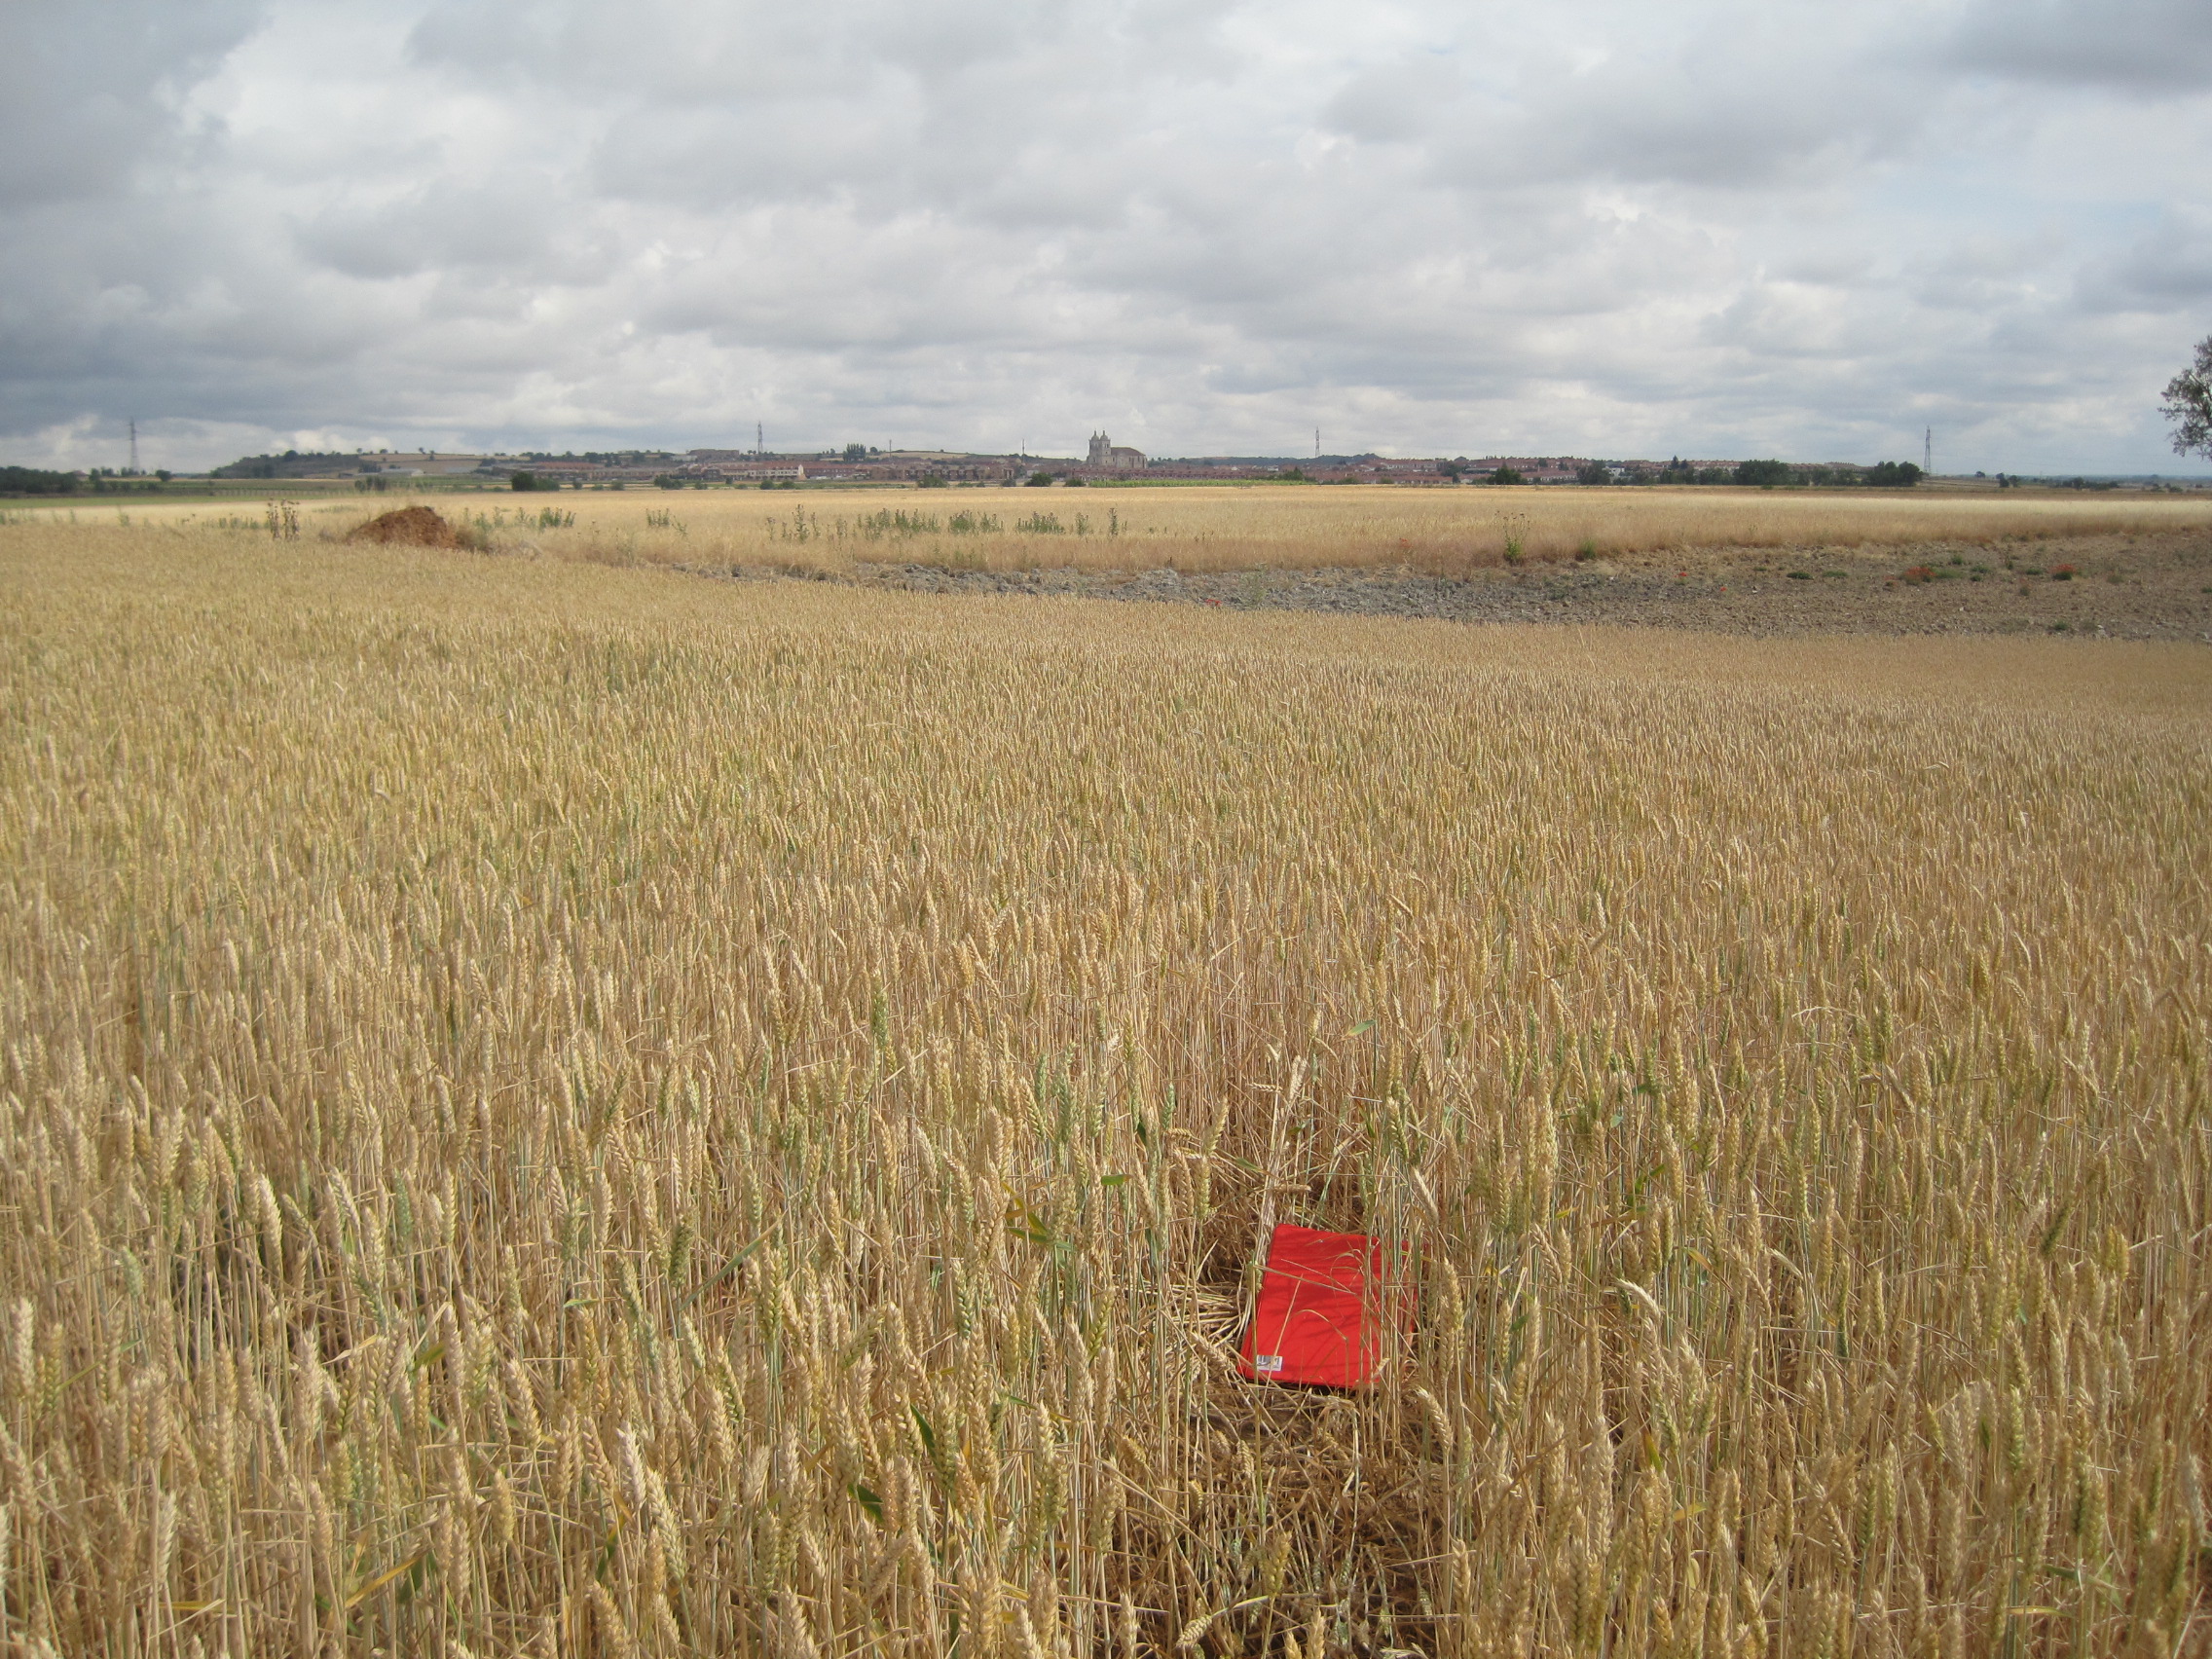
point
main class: Cropland
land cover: Common wheat
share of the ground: > 75 %
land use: Agriculture (excluding fallow land and kitchen gardens)
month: June
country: ES
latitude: 41.7393
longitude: -4.7028
